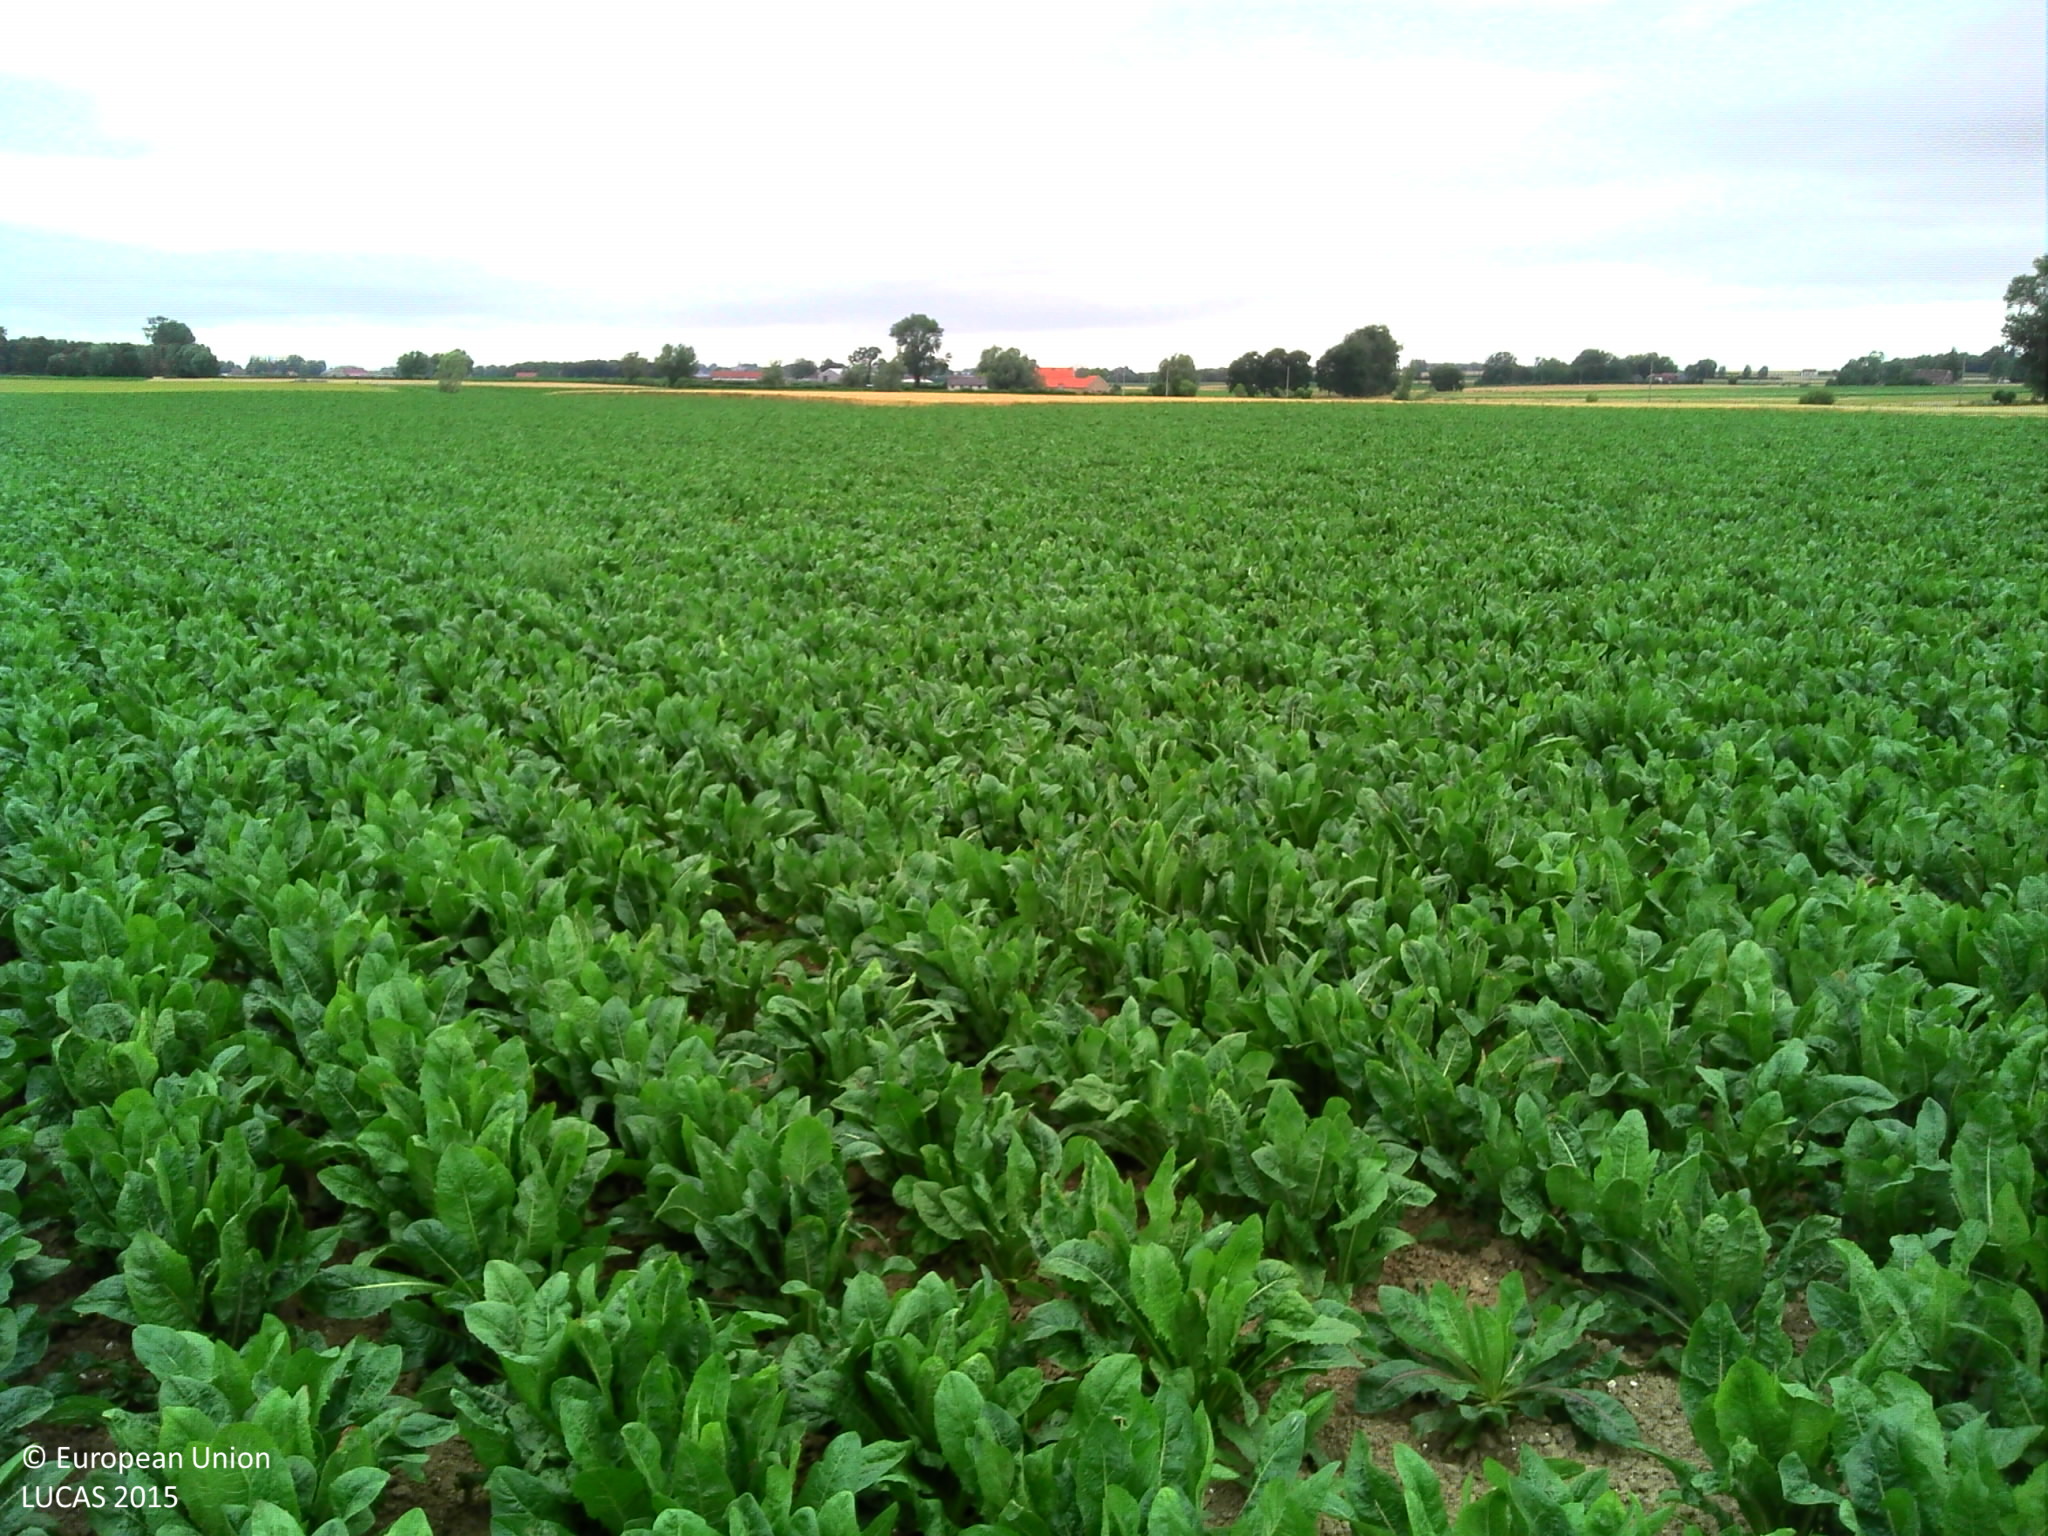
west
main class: Cropland
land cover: Sugar beet
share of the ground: > 75 %
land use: Agriculture (excluding fallow land and kitchen gardens)
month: July
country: FR
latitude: 50.8686
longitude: 2.3845
